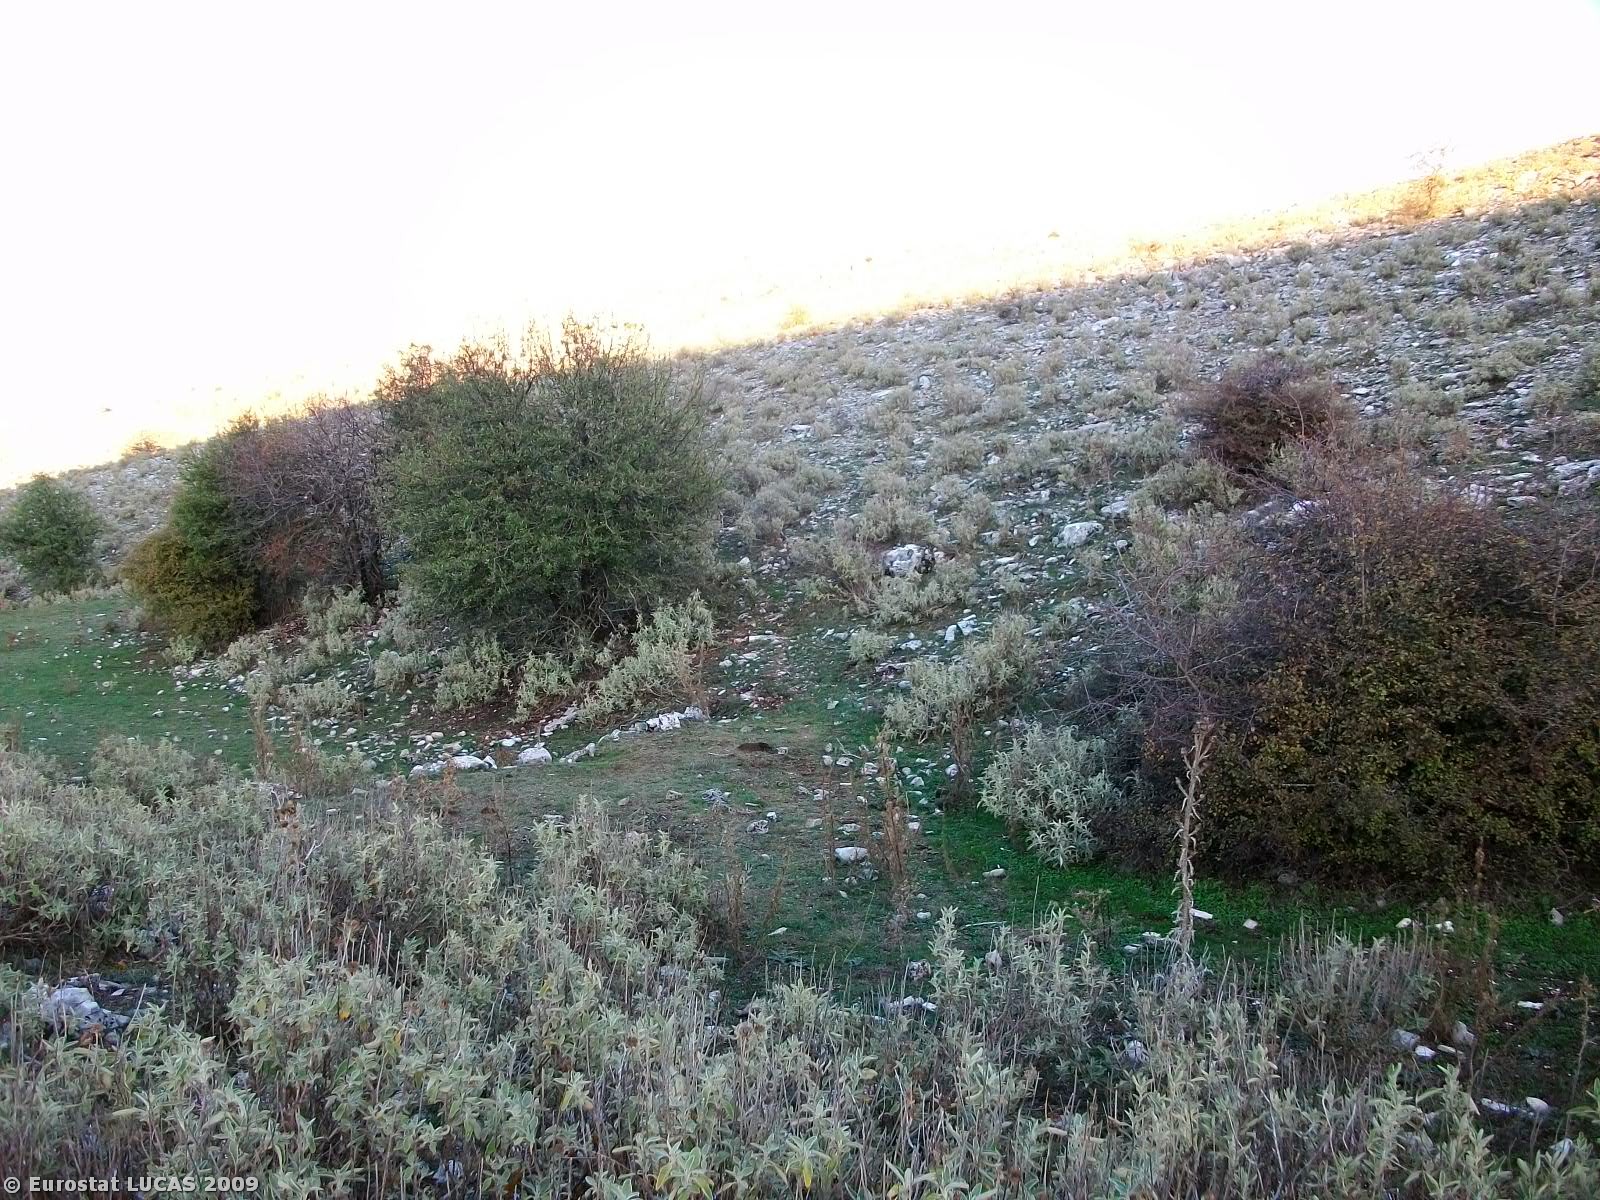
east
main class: Shrubland
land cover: Shrubland without tree cover
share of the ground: 50 - 75 %
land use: Agriculture (excluding fallow land and kitchen gardens)
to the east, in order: Shrubland without tree cover; Grassland without tree/shrub cover; Shrubland without tree cover; Bare land; Grassland with sparse tree/shrub cover; Shrubland without tree cover
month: October
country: GR
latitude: 39.6723
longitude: 20.2694
